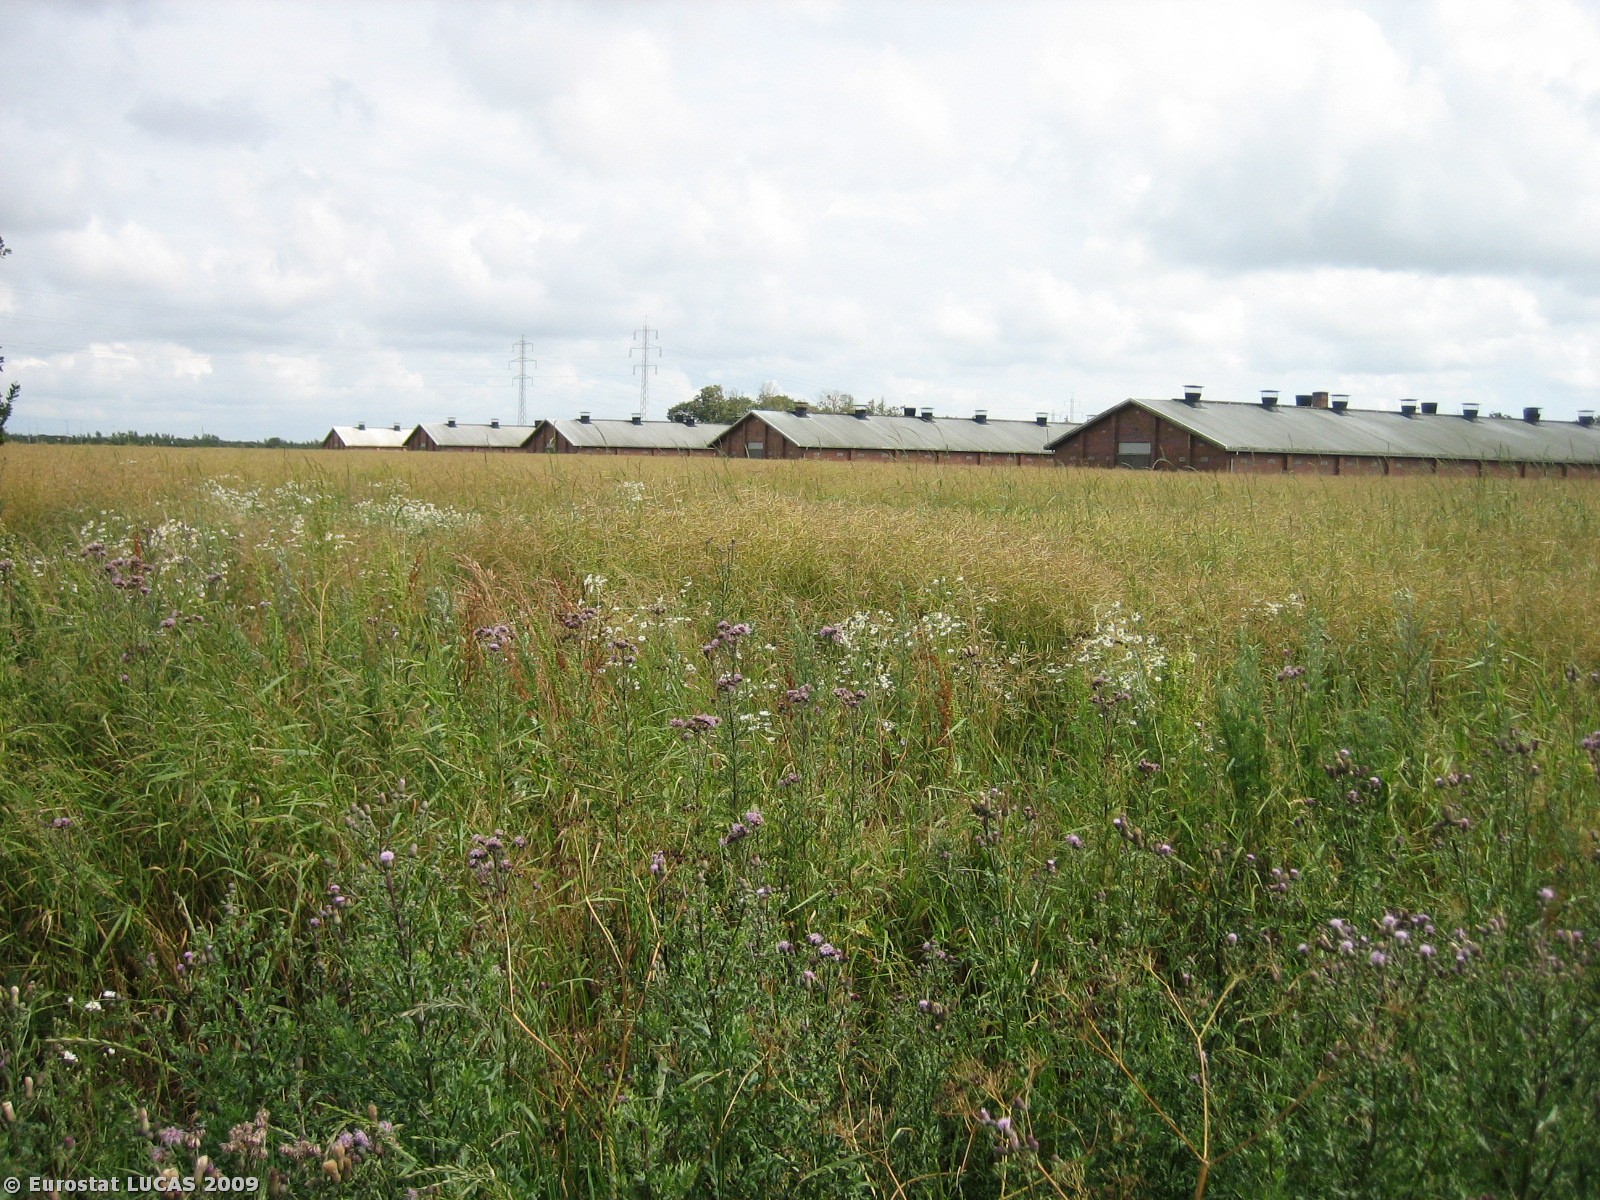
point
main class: Cropland
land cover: Rape and turnip rape
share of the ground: > 75 %
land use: Agriculture (excluding fallow land and kitchen gardens)
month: July
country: DK
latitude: 55.5138
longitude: 8.4969
